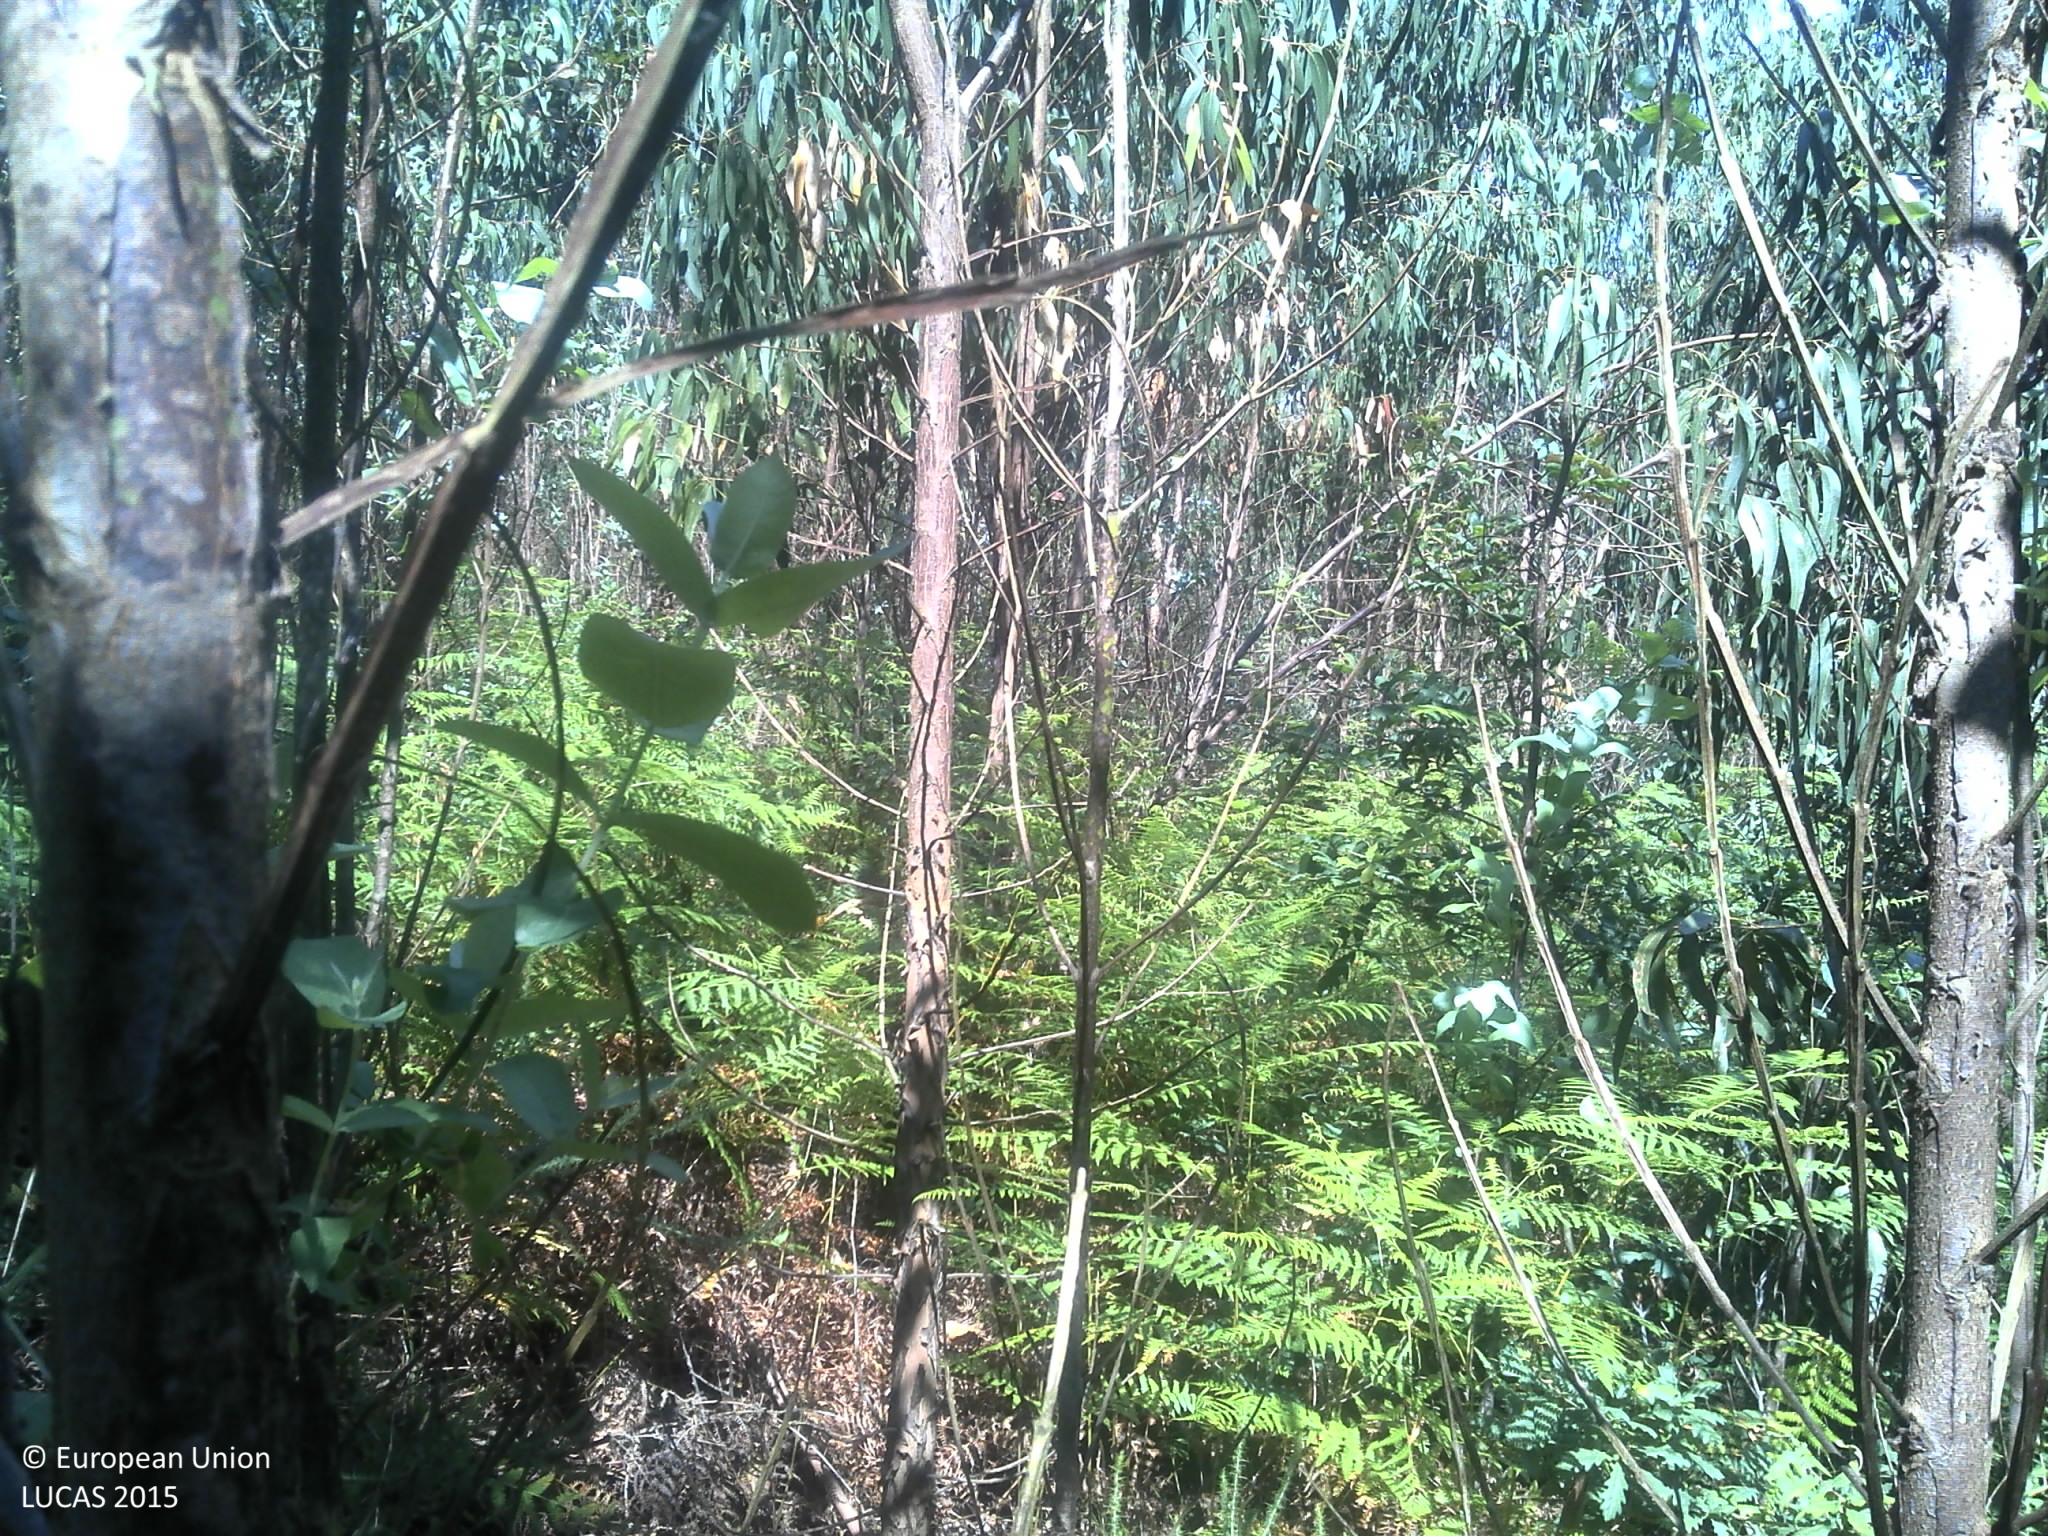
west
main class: Woodland
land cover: Broadleaved woodland
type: exotic forest
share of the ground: > 75 %
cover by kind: broadleaved forest trees 80 %, shrubs 15 %, unconsolidated bare surface 5 %
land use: Forestry
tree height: > 5 m
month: June
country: PT
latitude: 41.6057
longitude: -8.6520
